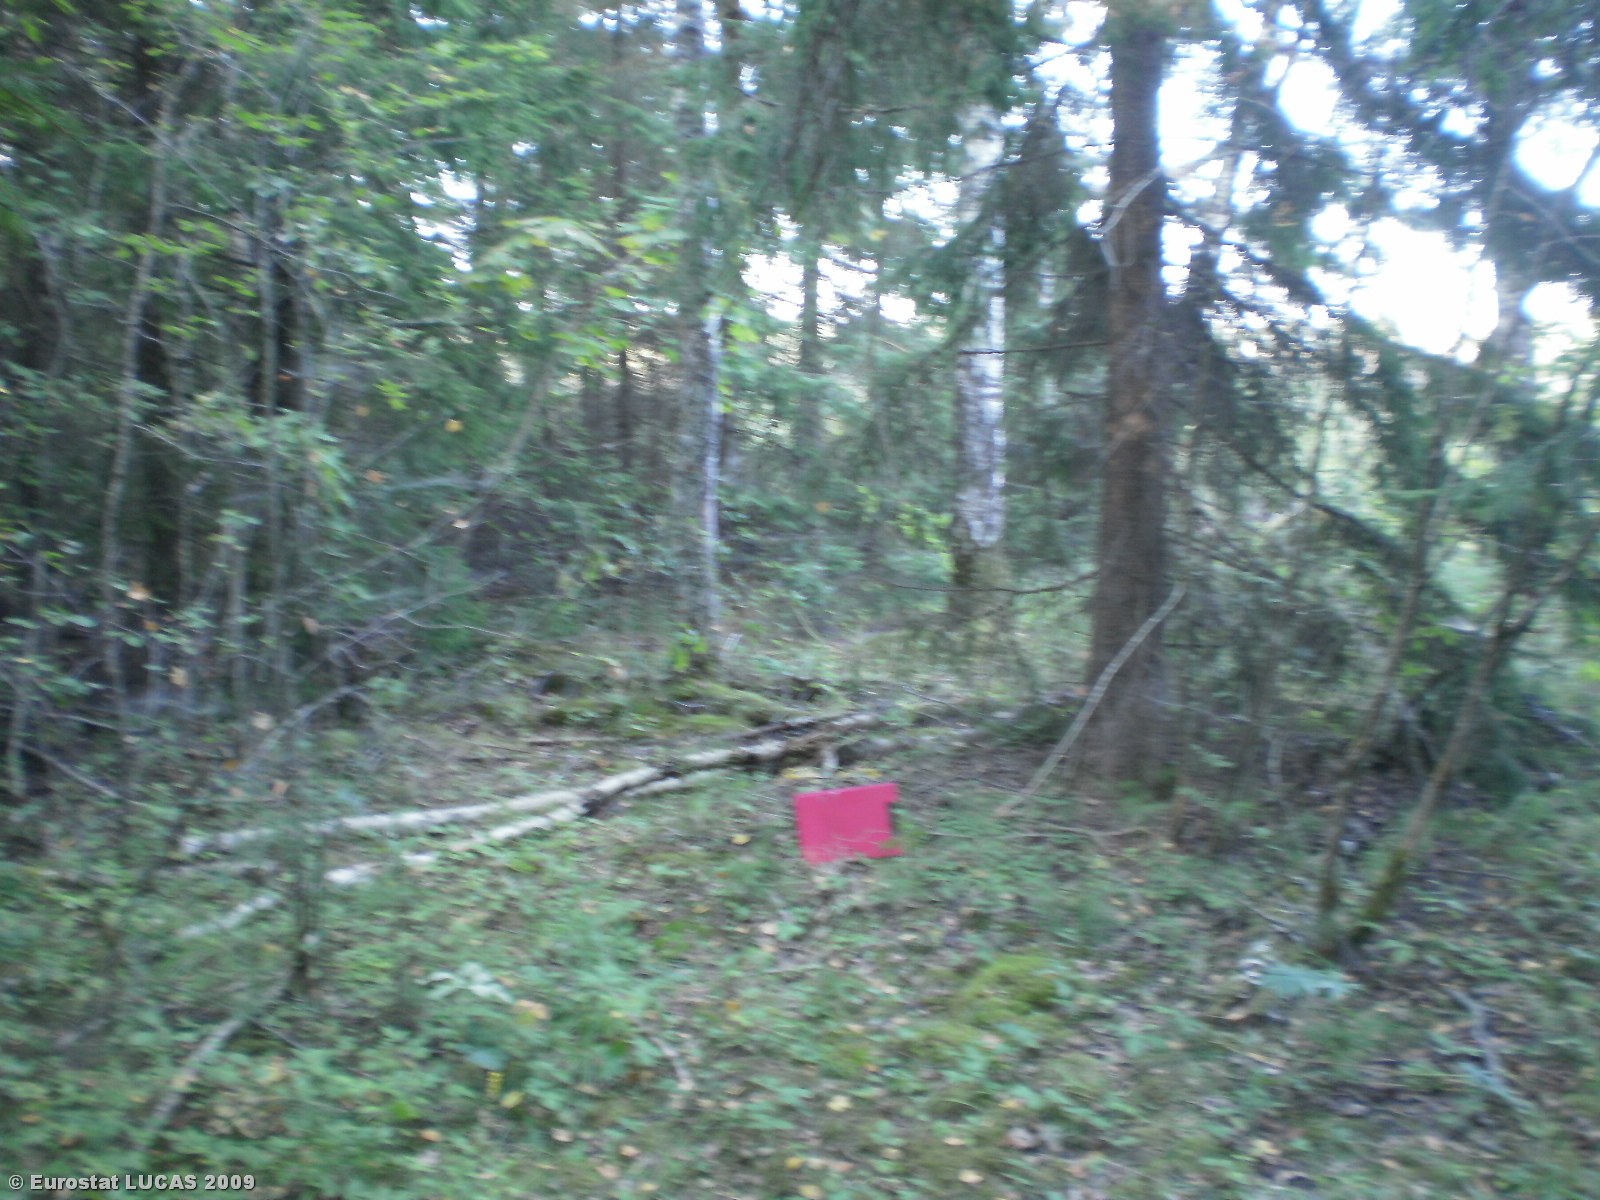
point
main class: Woodland
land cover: Mixed woodland
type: hemiboreal forest and nemoral coniferous forest and mixed broadleaved-coniferous forest
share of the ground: > 75 %
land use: Forestry
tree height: > 5 m
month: August
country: LT
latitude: 55.4329
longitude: 24.9506
